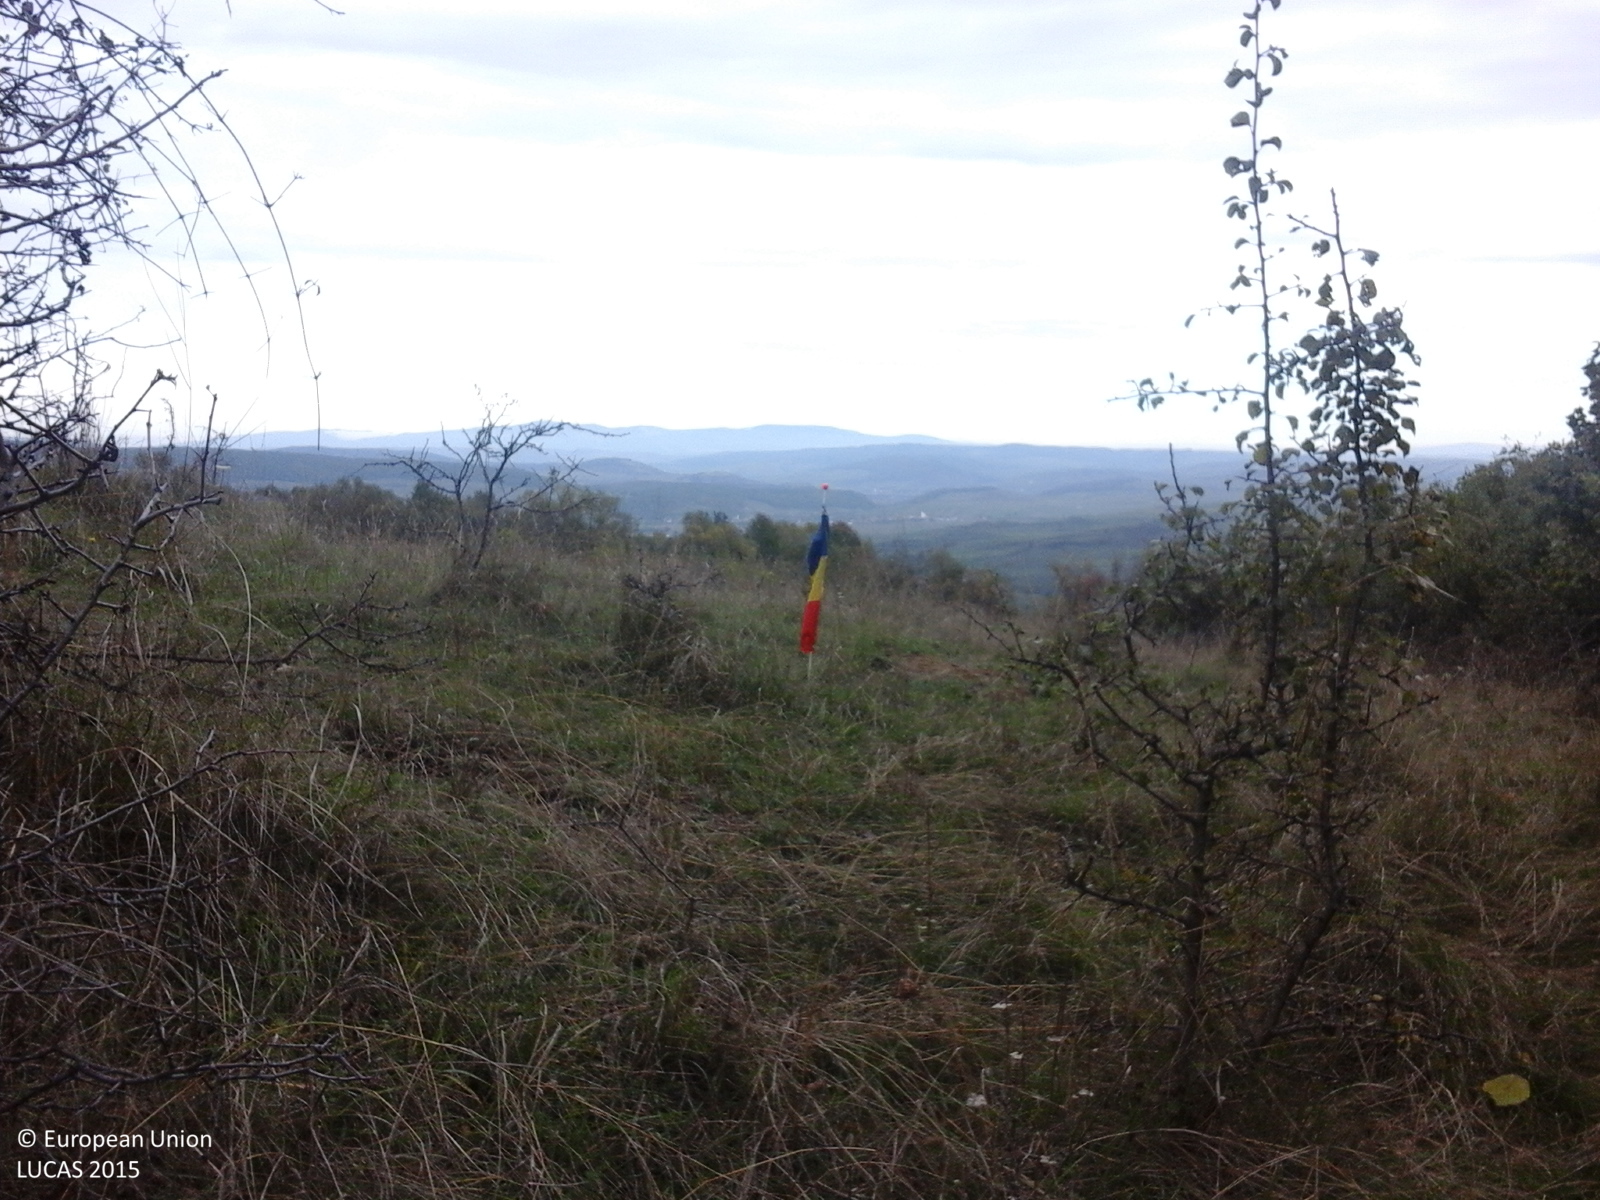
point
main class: Grassland
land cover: Grassland with sparse tree/shrub cover
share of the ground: > 75 %
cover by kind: herbaceous plants 85 %, shrubs 10 %, broadleaved forest trees 5 %
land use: Agriculture (excluding fallow land and kitchen gardens)
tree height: < 5 m
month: October
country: RO
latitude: 46.2343
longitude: 25.1539
